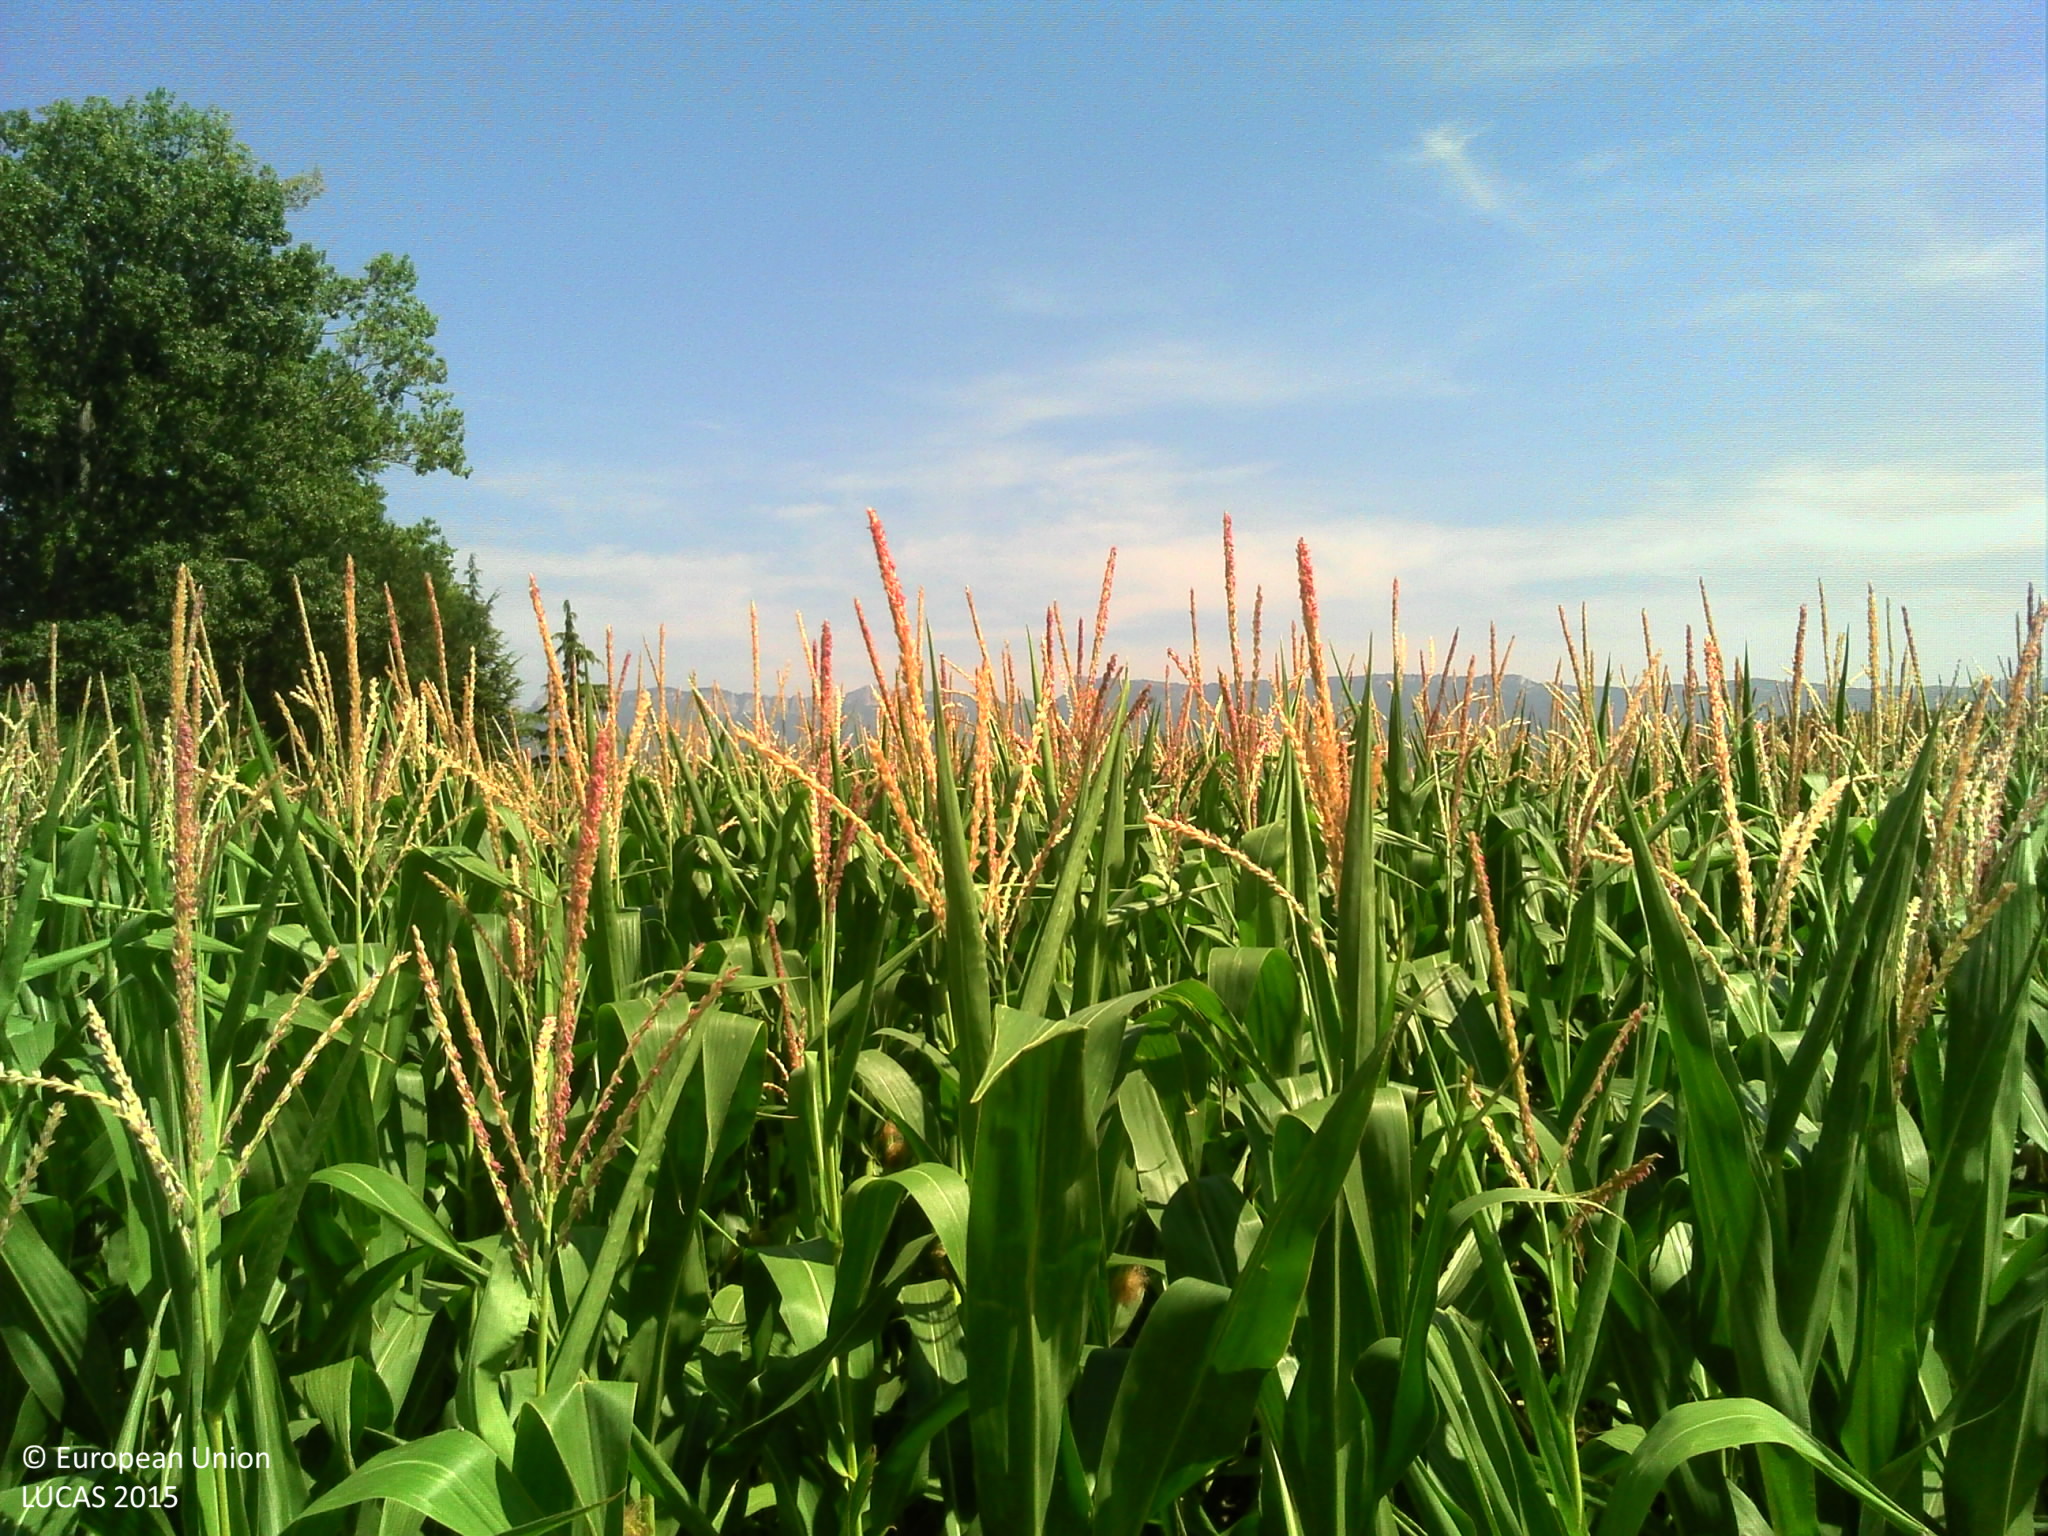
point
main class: Cropland
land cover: Maize
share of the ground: > 75 %
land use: Agriculture (excluding fallow land and kitchen gardens)
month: July
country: FR
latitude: 44.9729
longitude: 5.0479
